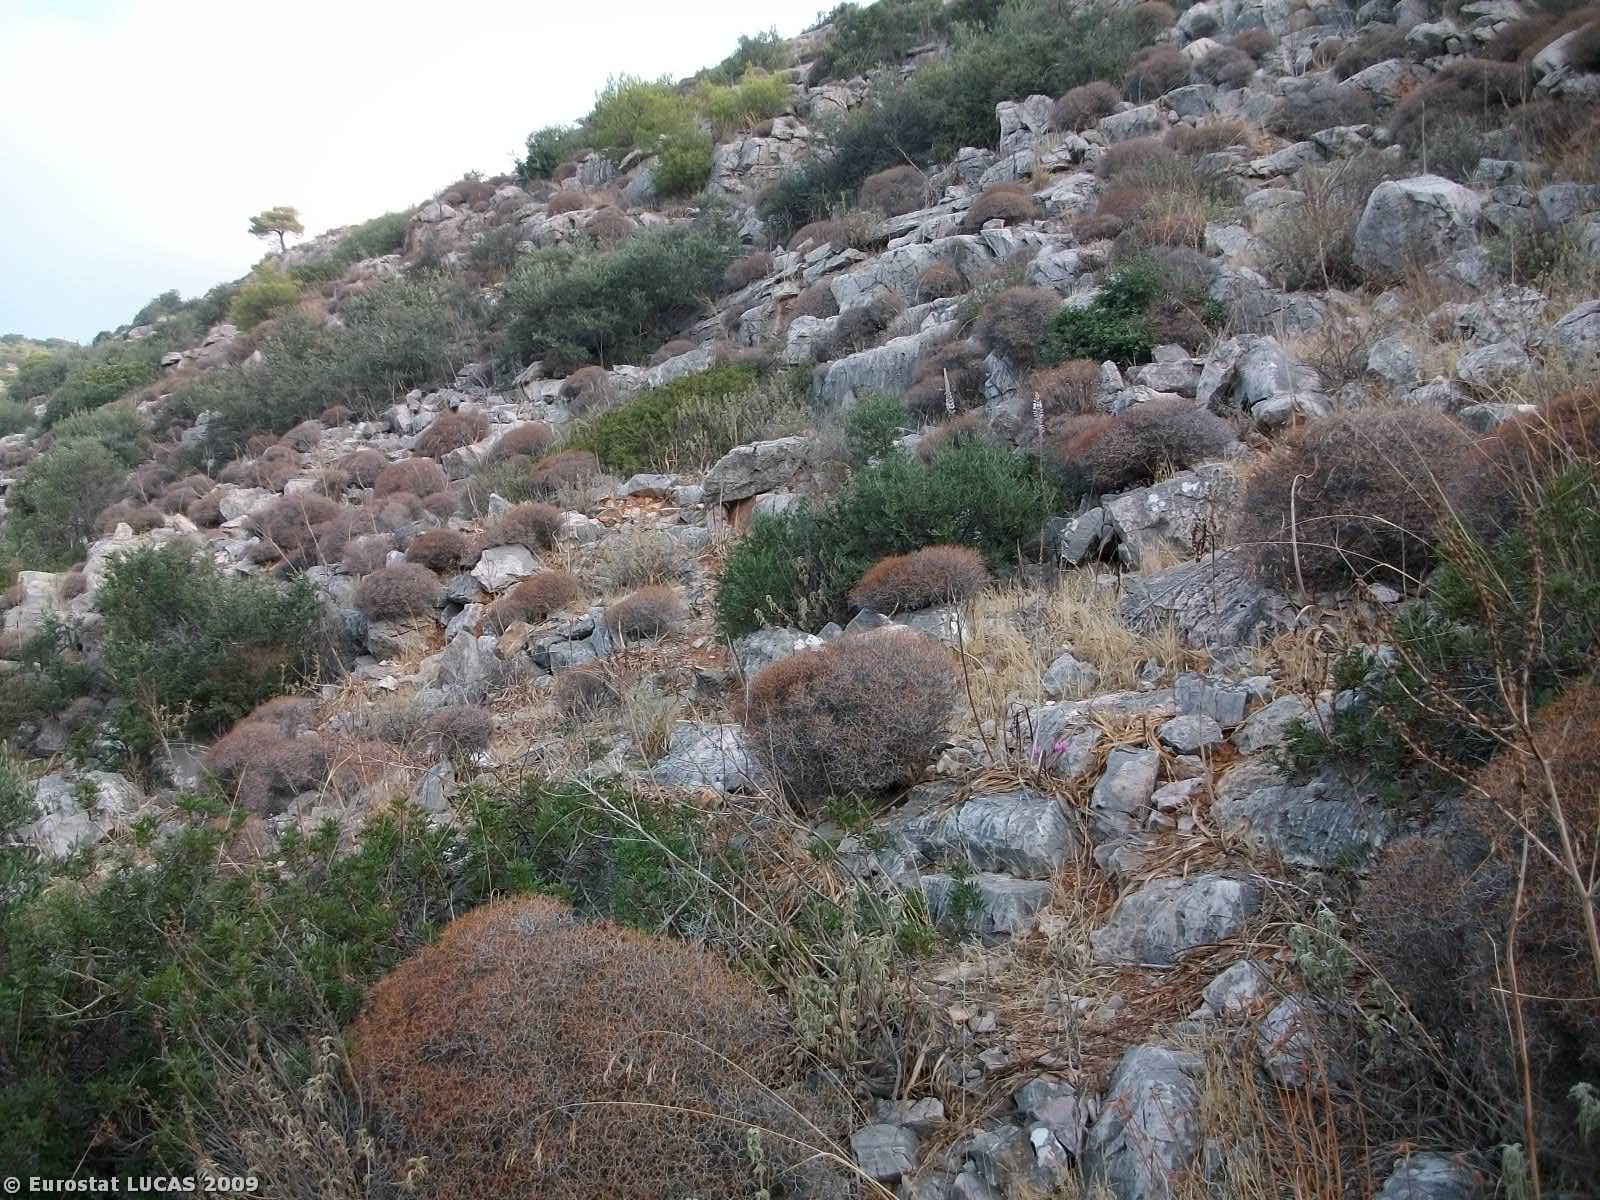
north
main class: Shrubland
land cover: Shrubland with sparse tree cover
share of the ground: 50 - 75 %
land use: Unused
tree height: < 5 m
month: October
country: GR
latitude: 37.8158
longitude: 23.8263
